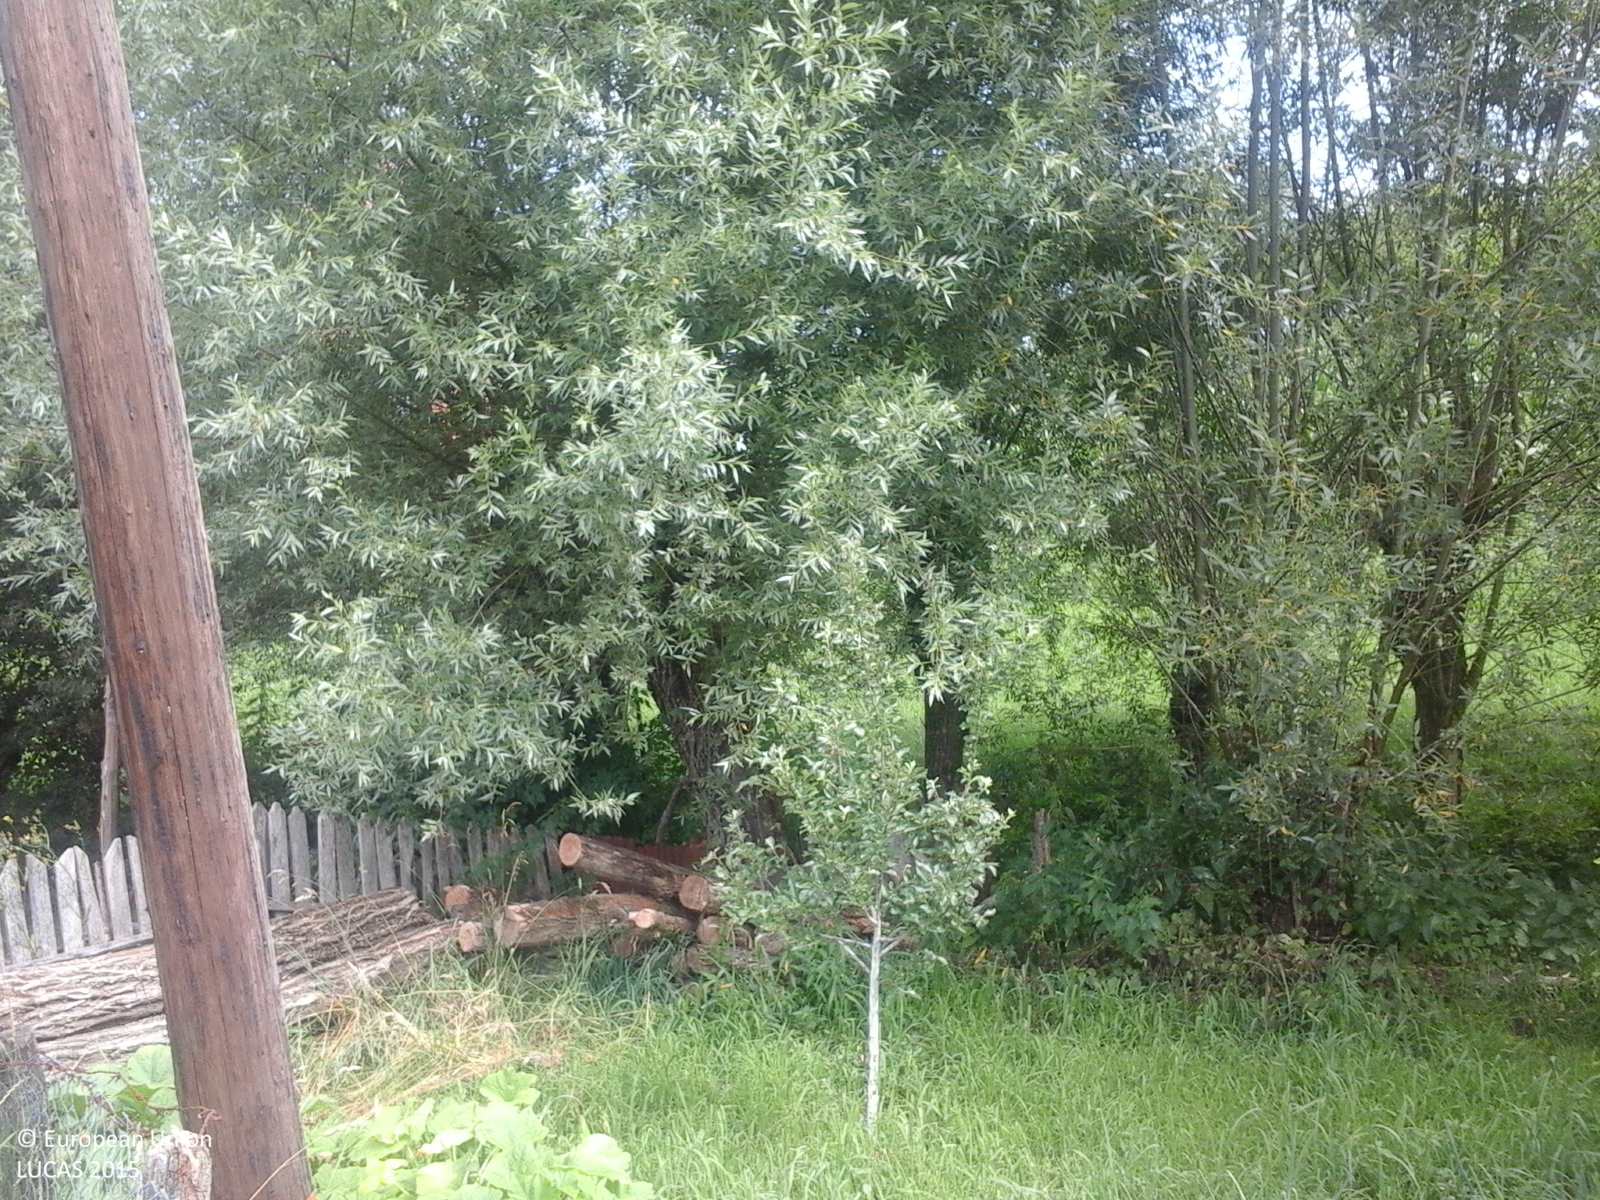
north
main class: Cropland
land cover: Apple fruit
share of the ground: > 75 %
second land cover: Grassland without tree/shrub cover
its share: > 75 %
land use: Agriculture (excluding fallow land and kitchen gardens)
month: July
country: RO
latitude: 45.1995
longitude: 24.7081
